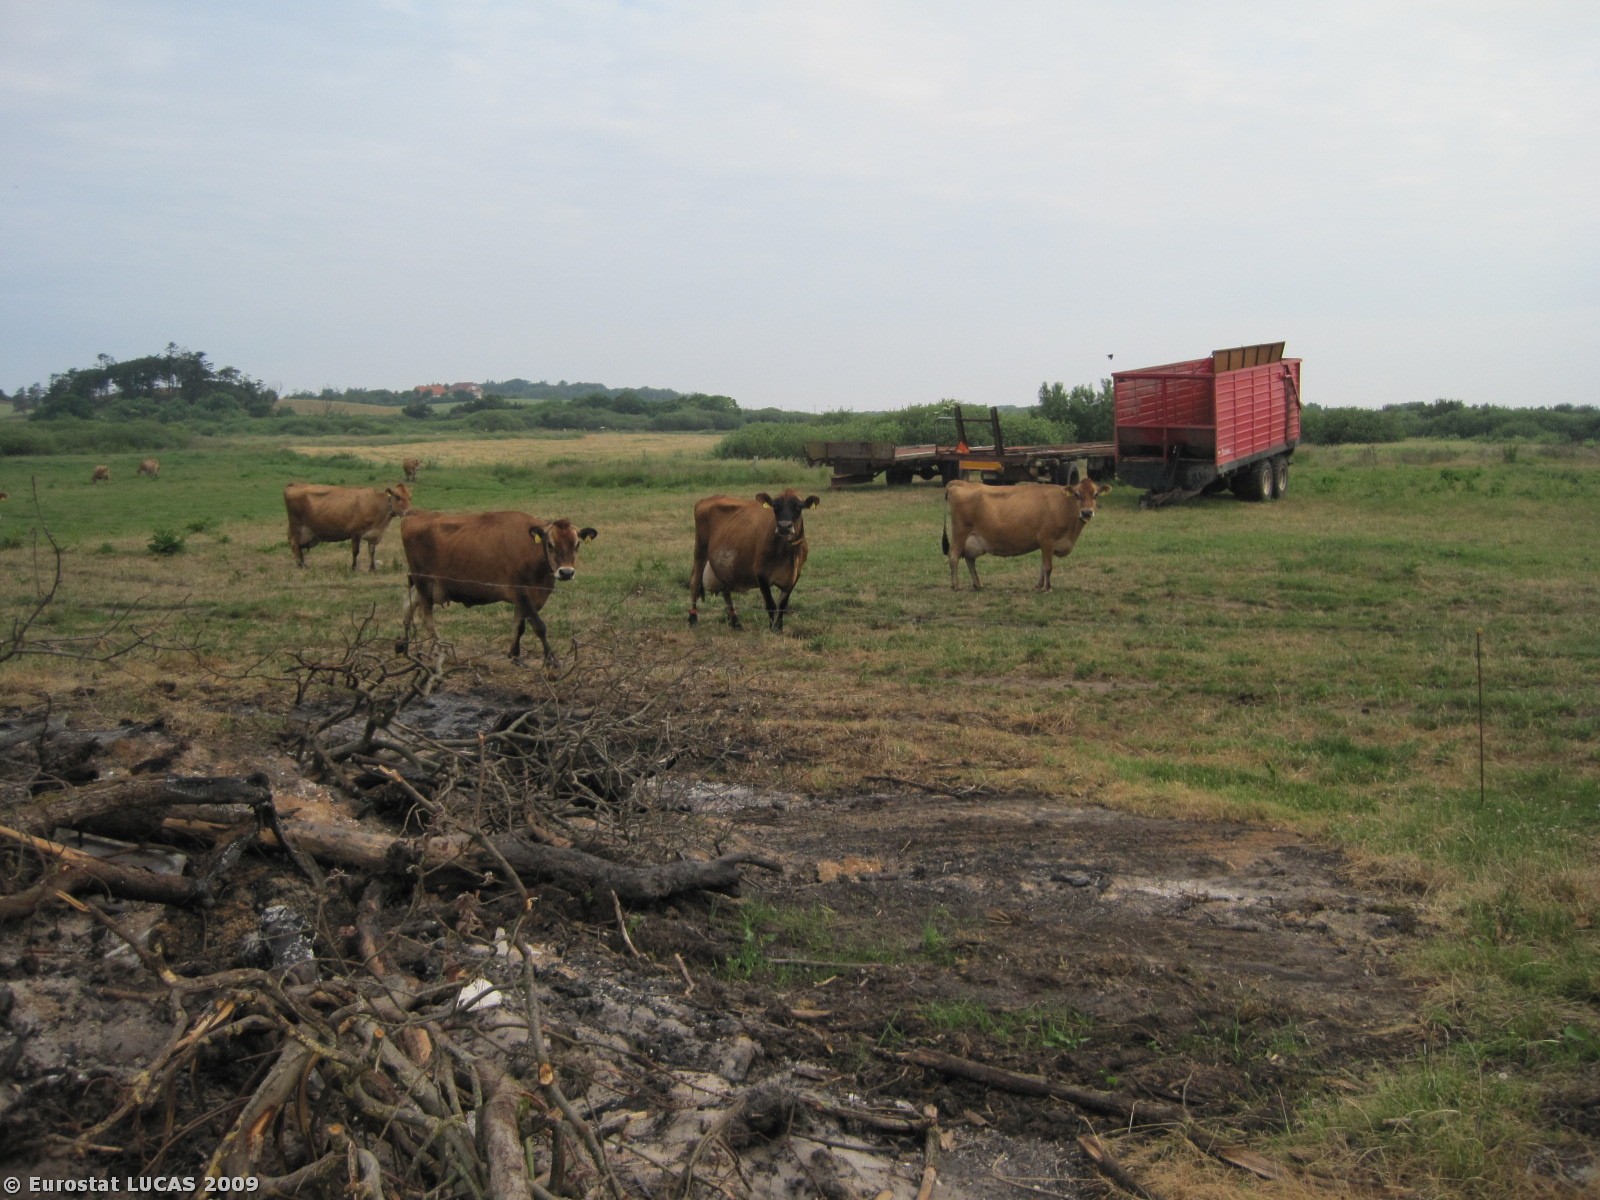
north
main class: Grassland
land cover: Grassland without tree/shrub cover
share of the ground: > 75 %
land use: Agriculture (excluding fallow land and kitchen gardens)
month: June
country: DK
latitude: 56.5385
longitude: 8.4895
